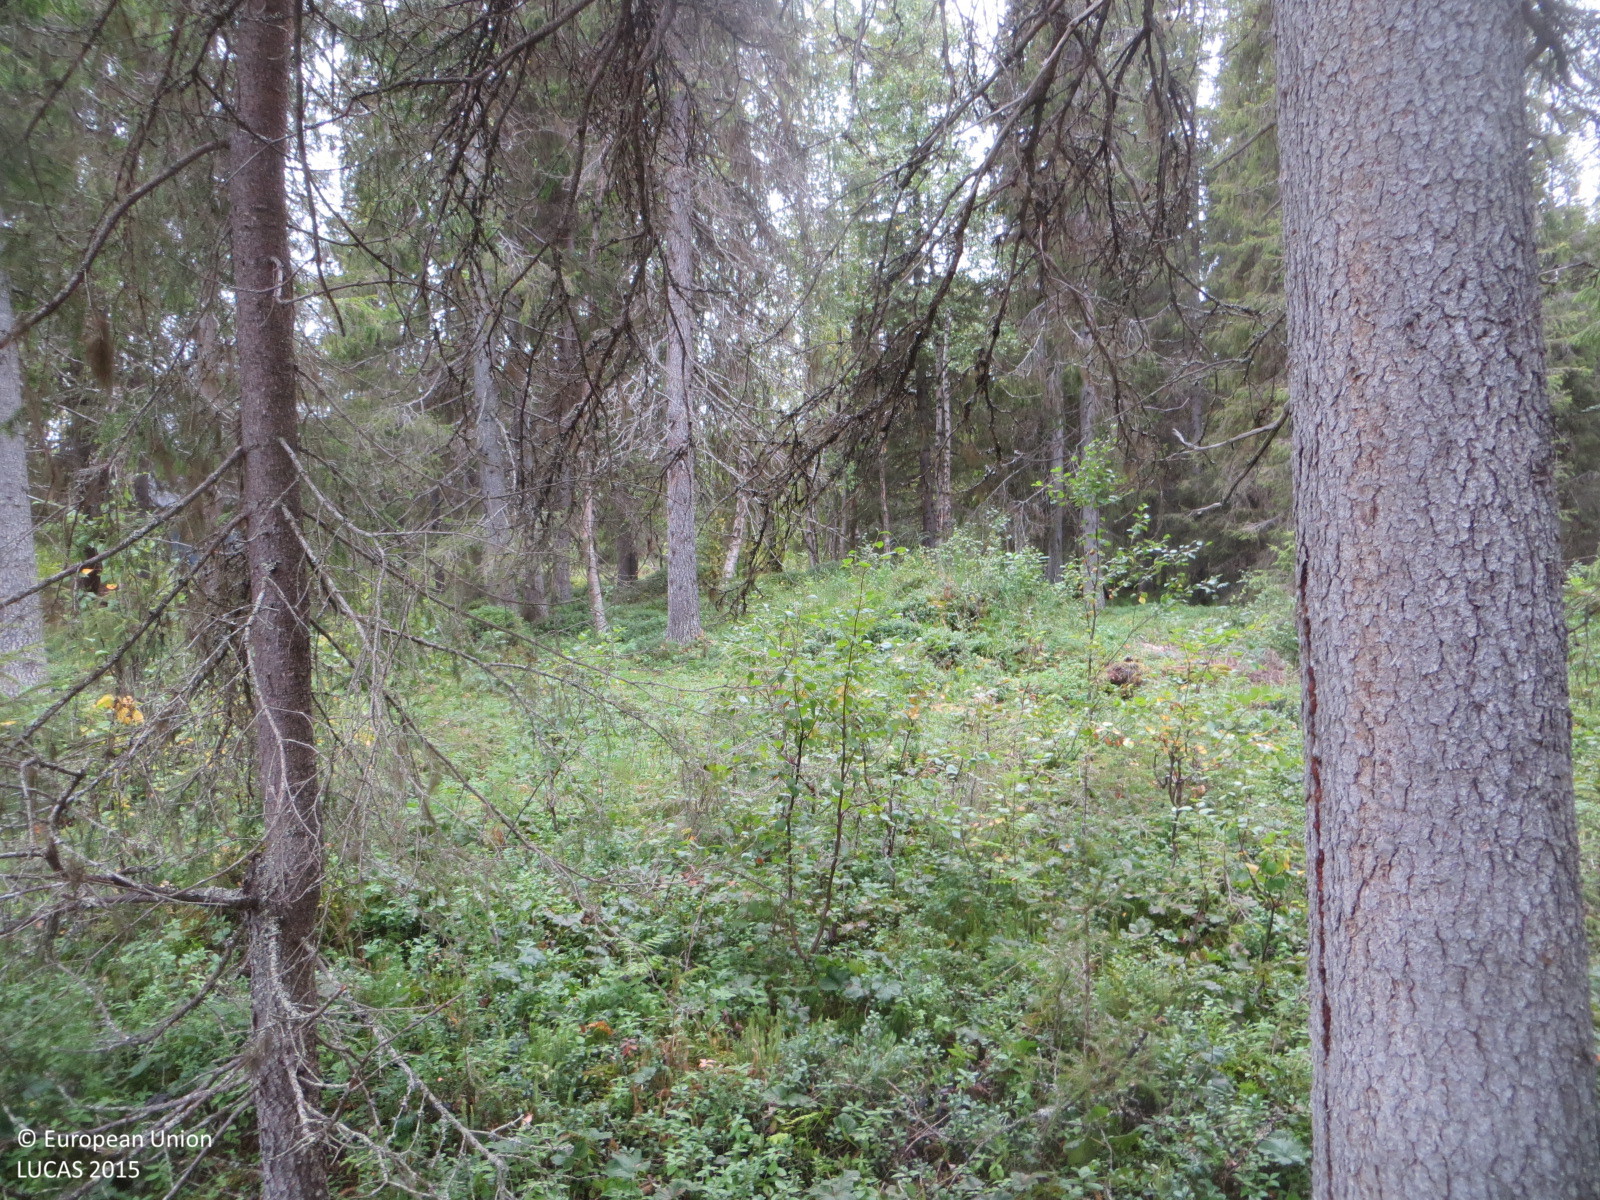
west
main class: Woodland
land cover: Spruce dominated coniferous woodland
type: boreal forest
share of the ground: > 75 %
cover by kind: coniferous forest trees 75 %, shrubs 25 %
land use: Forestry
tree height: > 5 m
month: August
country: FI
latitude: 67.5331
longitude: 24.2600
